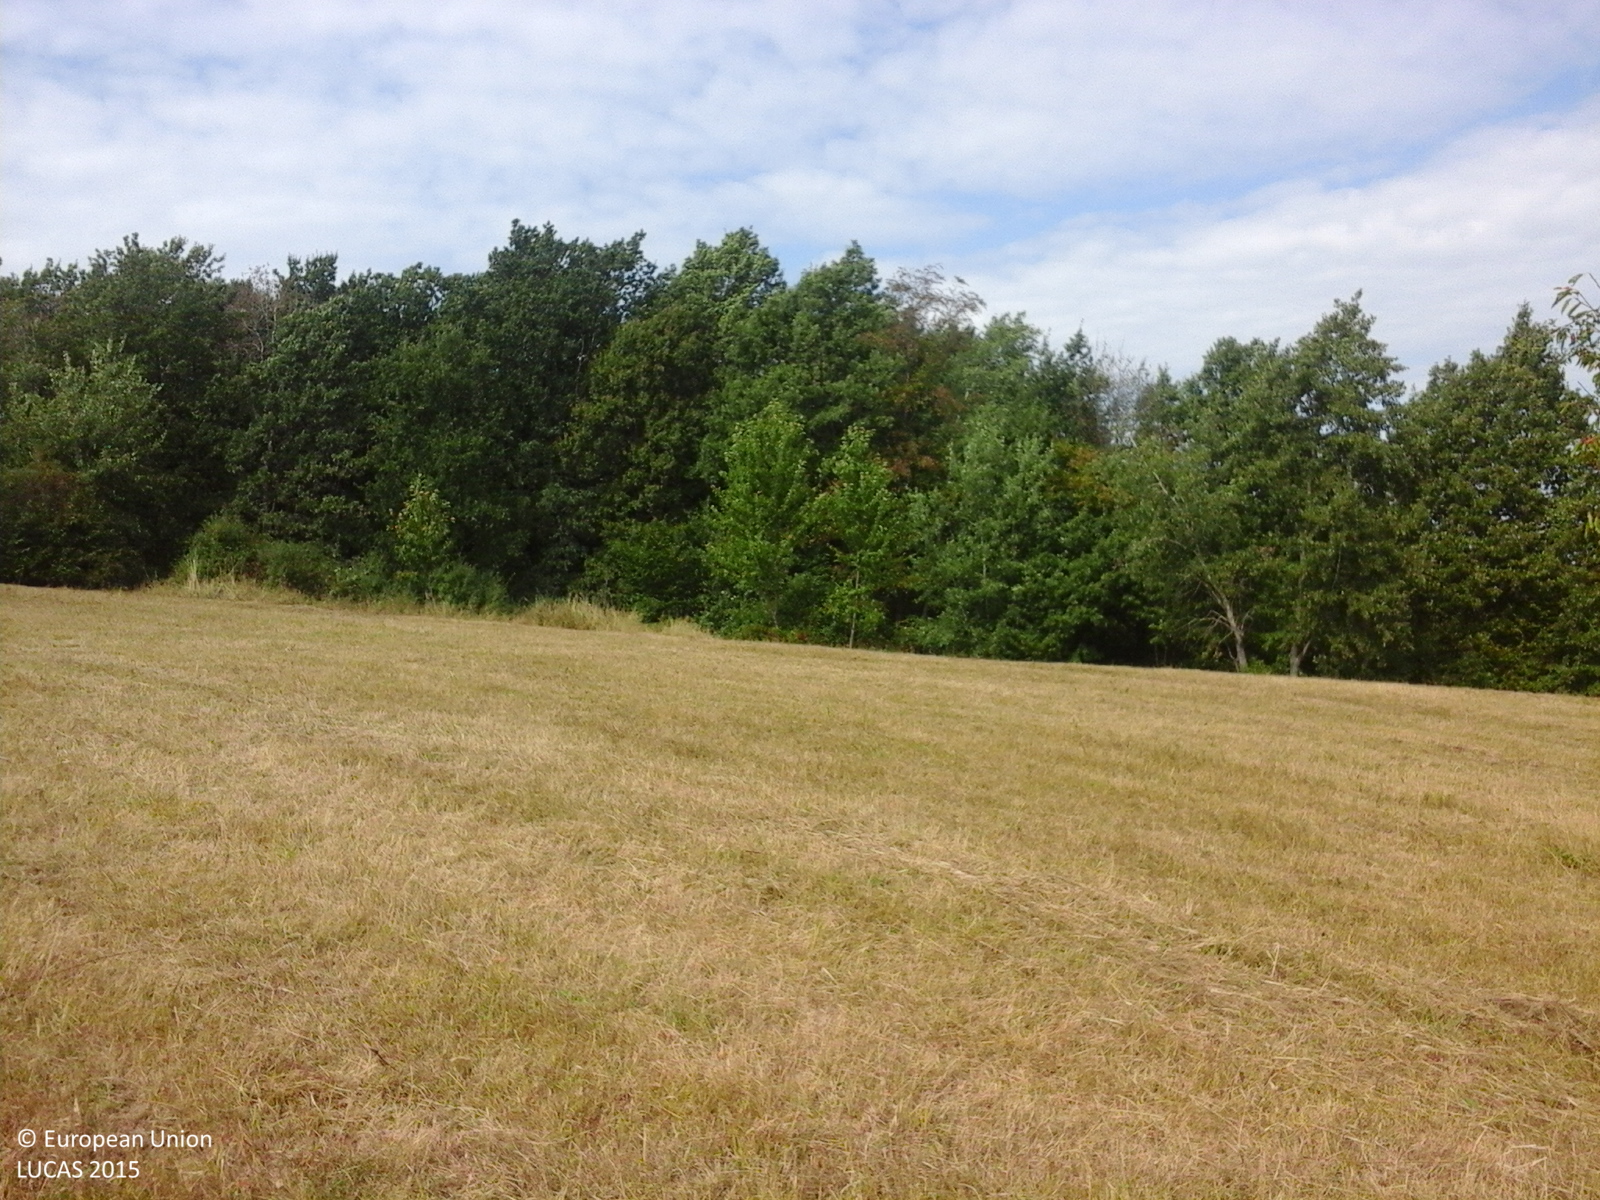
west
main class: Grassland
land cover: Grassland without tree/shrub cover
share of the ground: > 75 %
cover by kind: herbaceous plants 100 %
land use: Agriculture (excluding fallow land and kitchen gardens)
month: September
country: RO
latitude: 47.4744
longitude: 23.5422
